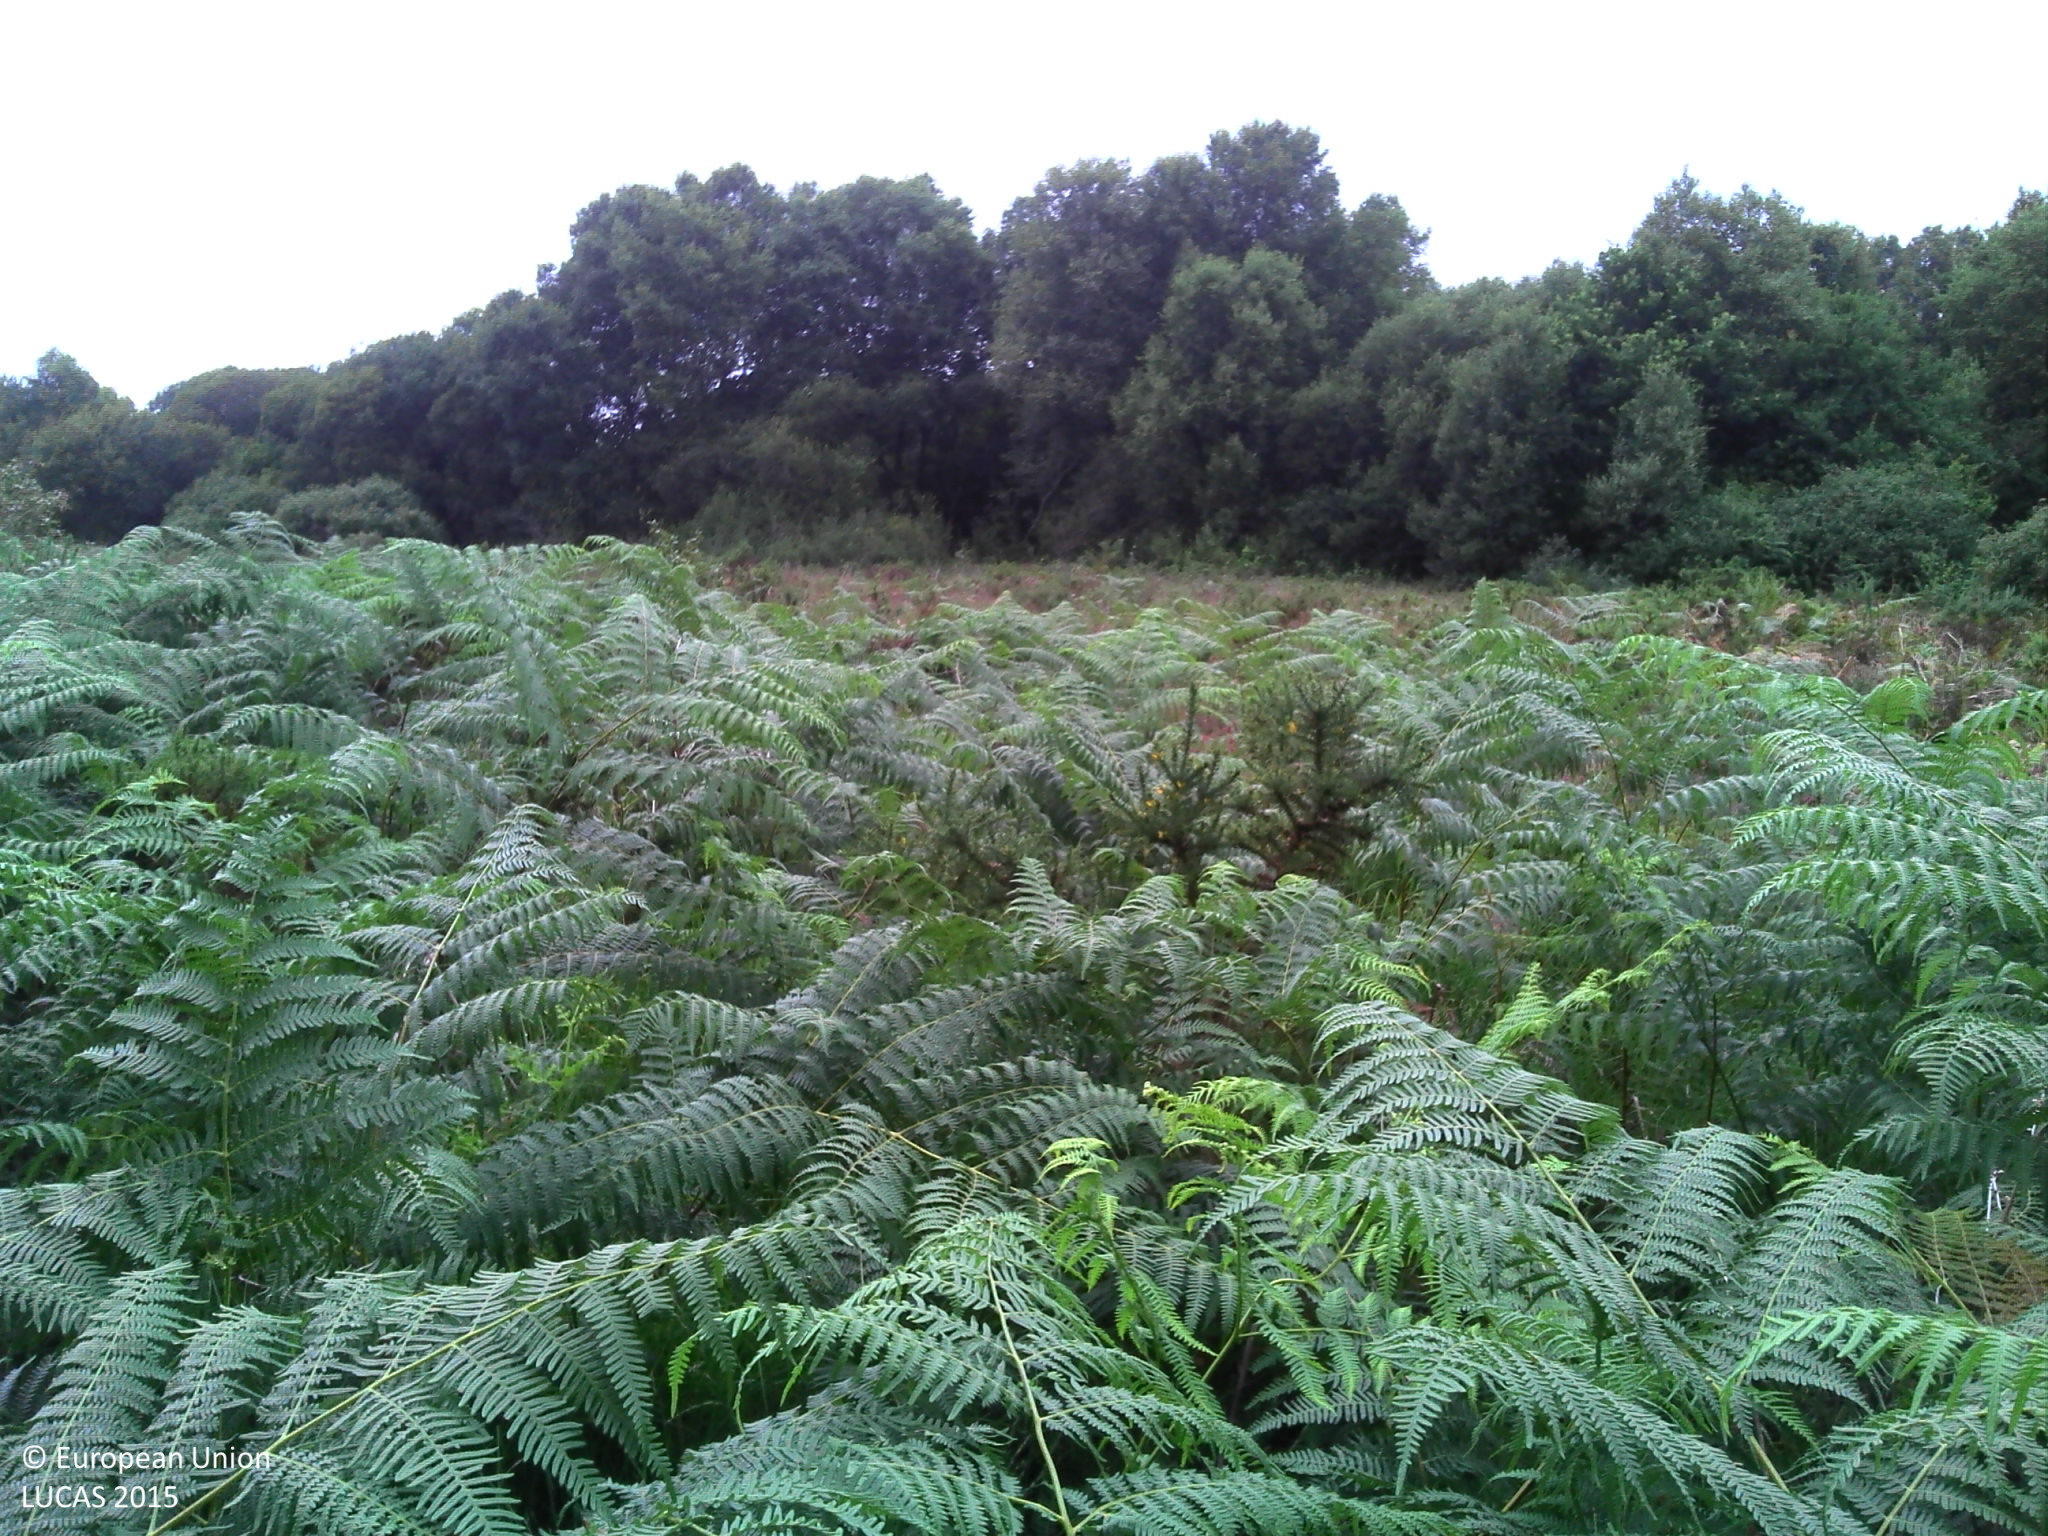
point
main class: Grassland
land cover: Spontaneously vegetated surfaces
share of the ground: > 75 %
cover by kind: herbaceous plants 95 %, shrubs 5 %
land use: Semi-natural and natural areas not in use
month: August
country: FR
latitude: 48.3644
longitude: -3.1239
